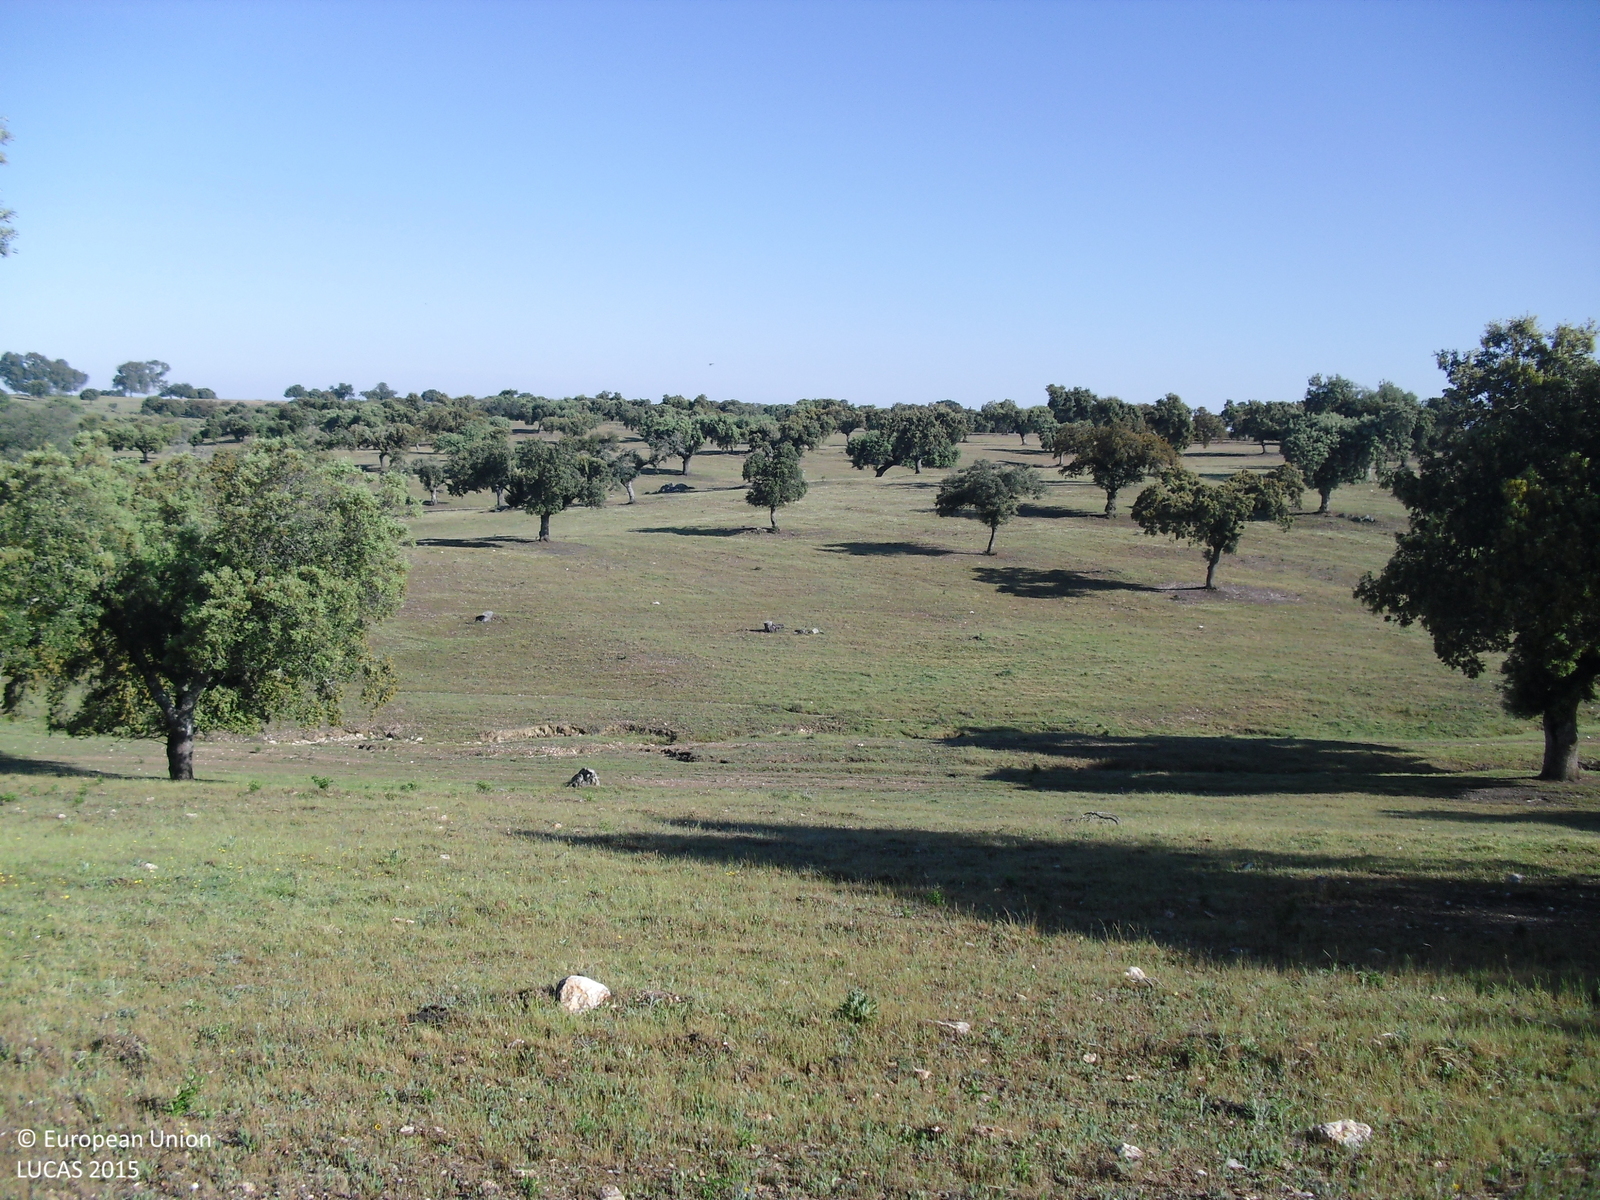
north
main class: Woodland
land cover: Broadleaved woodland
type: broadleaved evergreen forest
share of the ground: 10 - 25 %
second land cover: Spontaneously vegetated surfaces
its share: > 75 %
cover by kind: herbaceous plants 80 %, broadleaved forest trees 20 %
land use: Forestry
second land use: Agriculture (excluding fallow land and kitchen gardens)
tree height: > 5 m
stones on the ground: 10 - 25 %
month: April
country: ES
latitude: 39.5932
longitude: -7.4559
